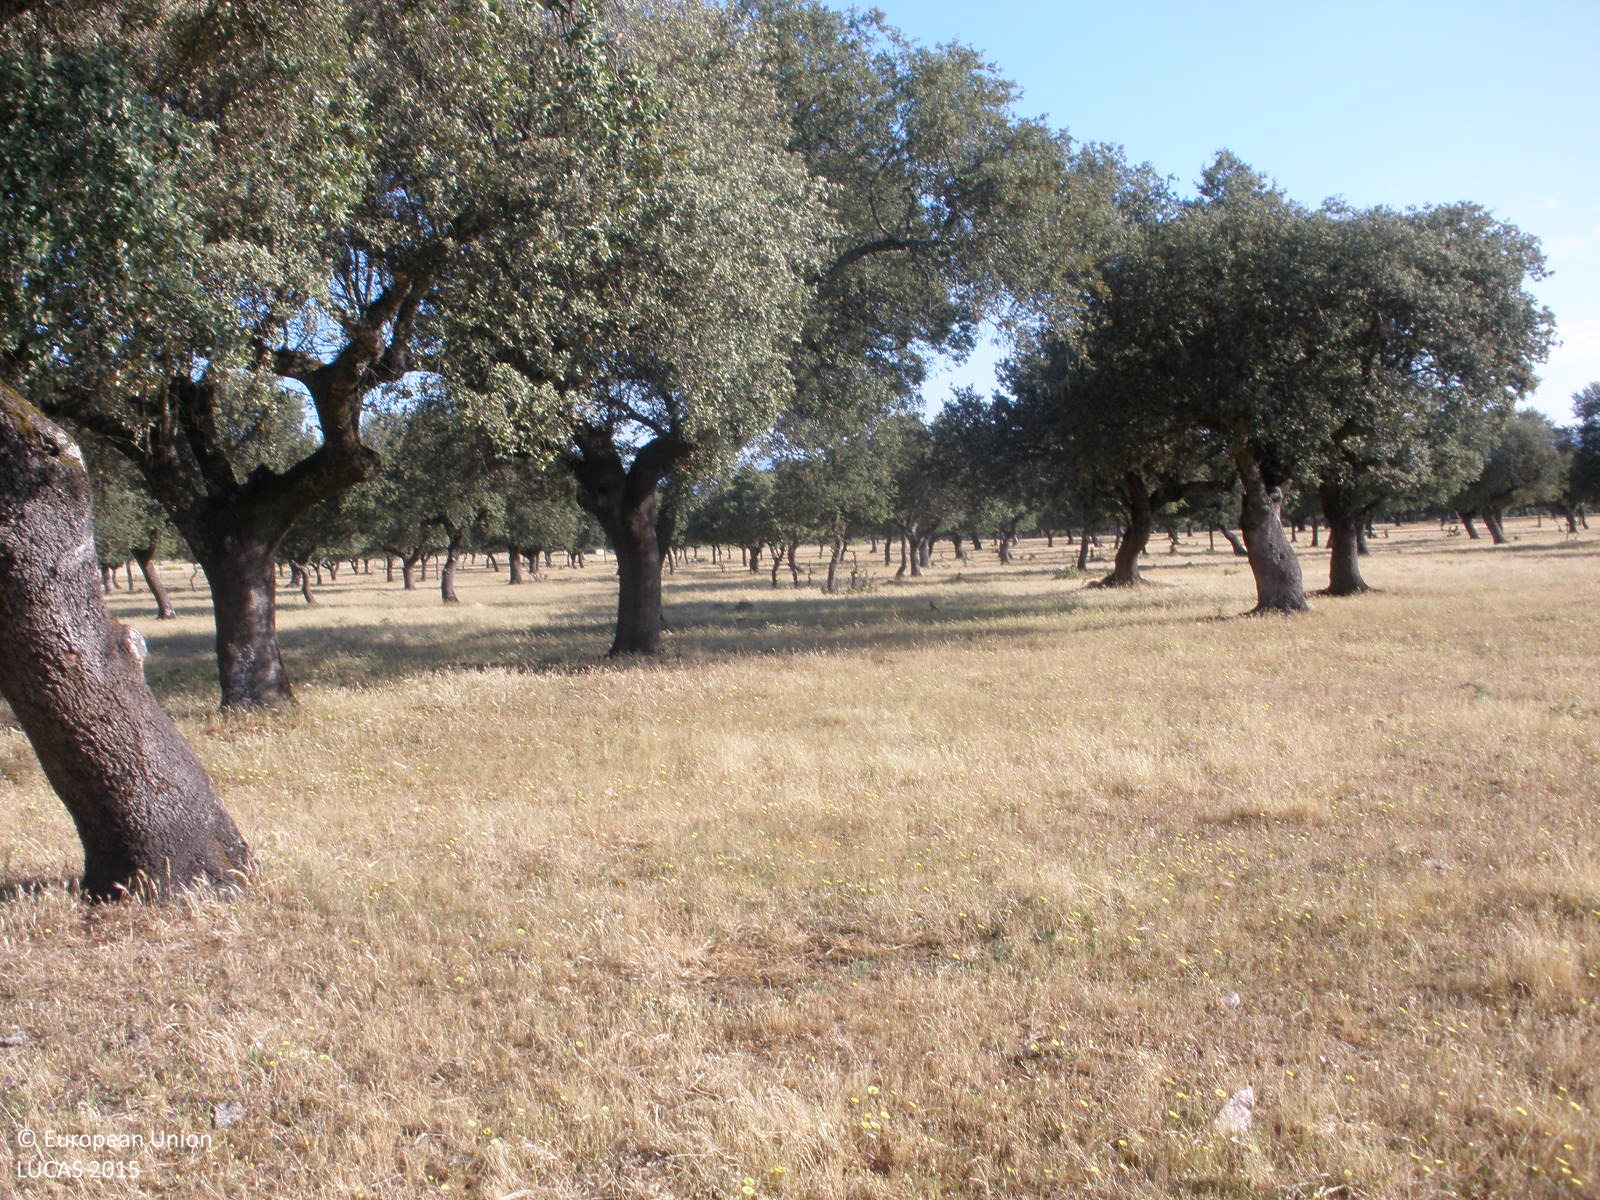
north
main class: Woodland
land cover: Broadleaved woodland
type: broadleaved evergreen forest
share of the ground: 25 - 50 %
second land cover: Grassland without tree/shrub cover
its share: > 75 %
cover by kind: herbaceous plants 70 %, broadleaved forest trees 30 %
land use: Forestry
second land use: Agriculture (excluding fallow land and kitchen gardens)
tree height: > 5 m
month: May
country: ES
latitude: 40.1685
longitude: -6.0541
